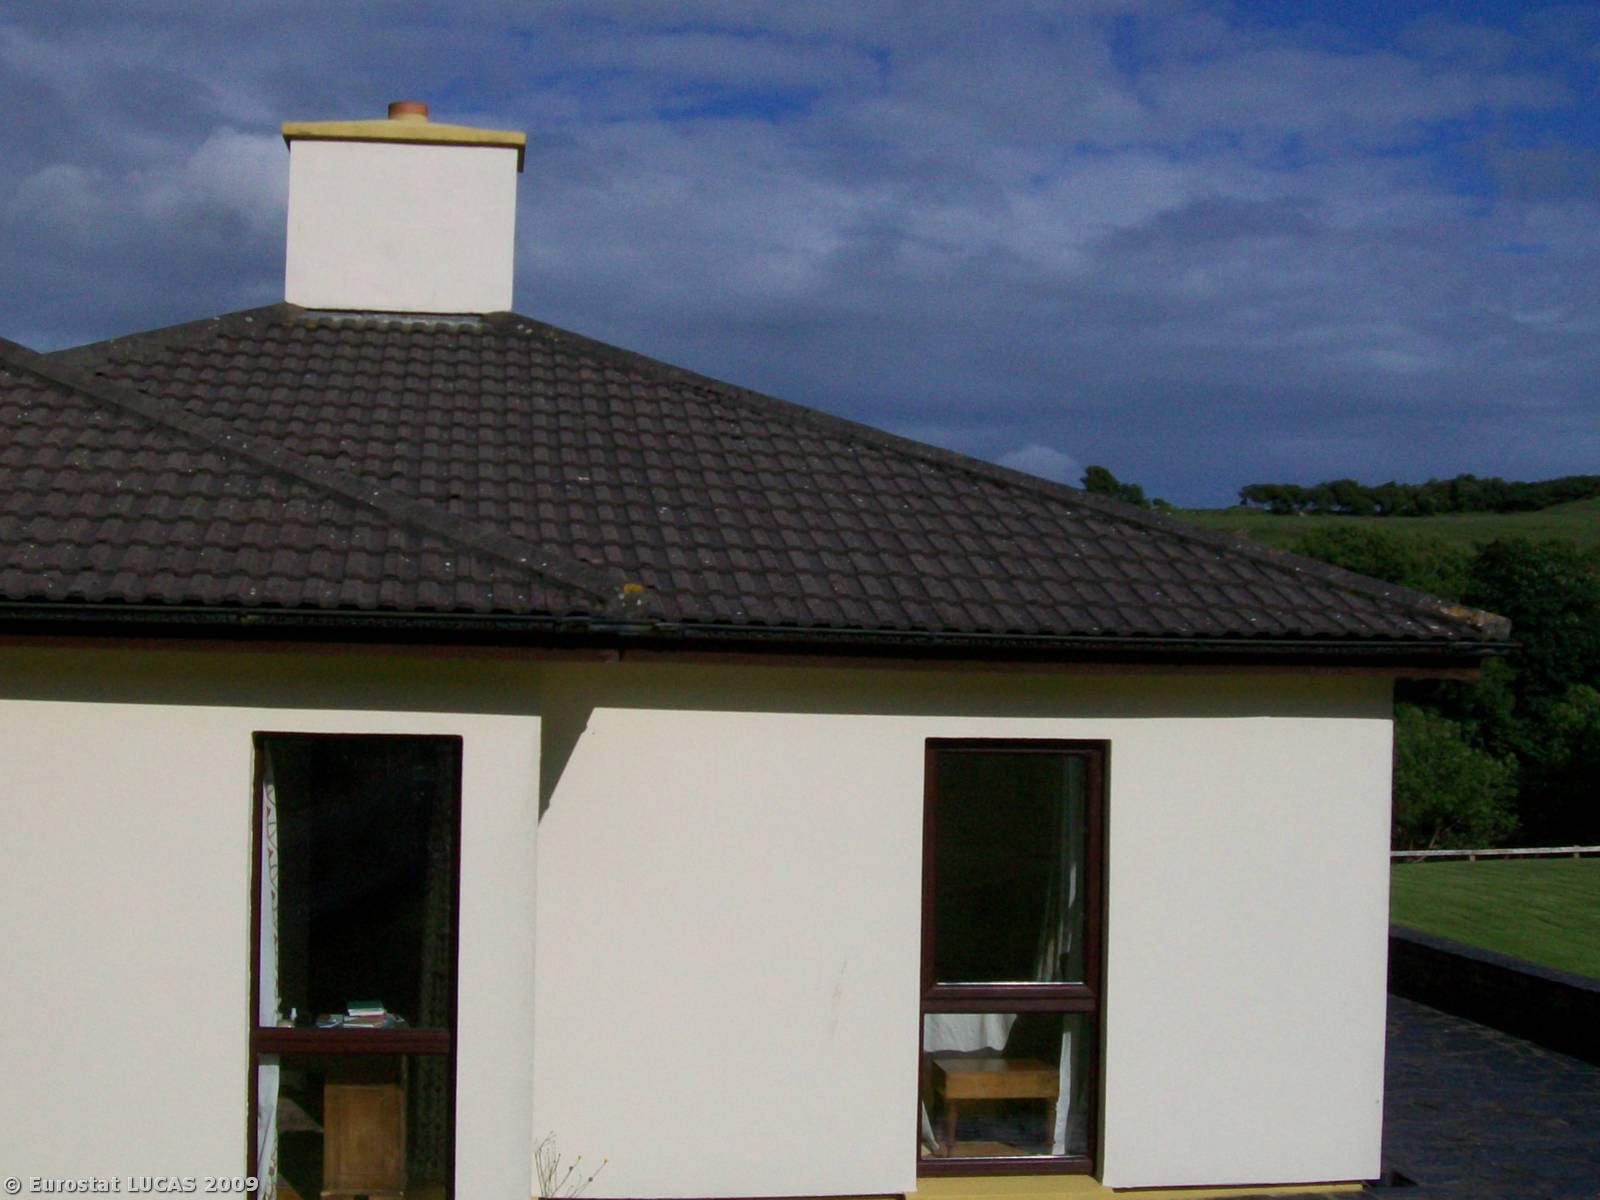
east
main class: Grassland
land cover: Grassland without tree/shrub cover
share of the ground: > 75 %
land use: Amenities, museums, leisure
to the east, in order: Grassland without tree/shrub cover; Fences; Broadleaved woodland; Bare land; Transitional water bodies; Bare land; Broadleaved woodland; Grassland without tree/shrub cover; Abandoned hedges; Grassland without tree/shrub cover
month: June
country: IE
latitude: 51.5510
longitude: -9.3947
